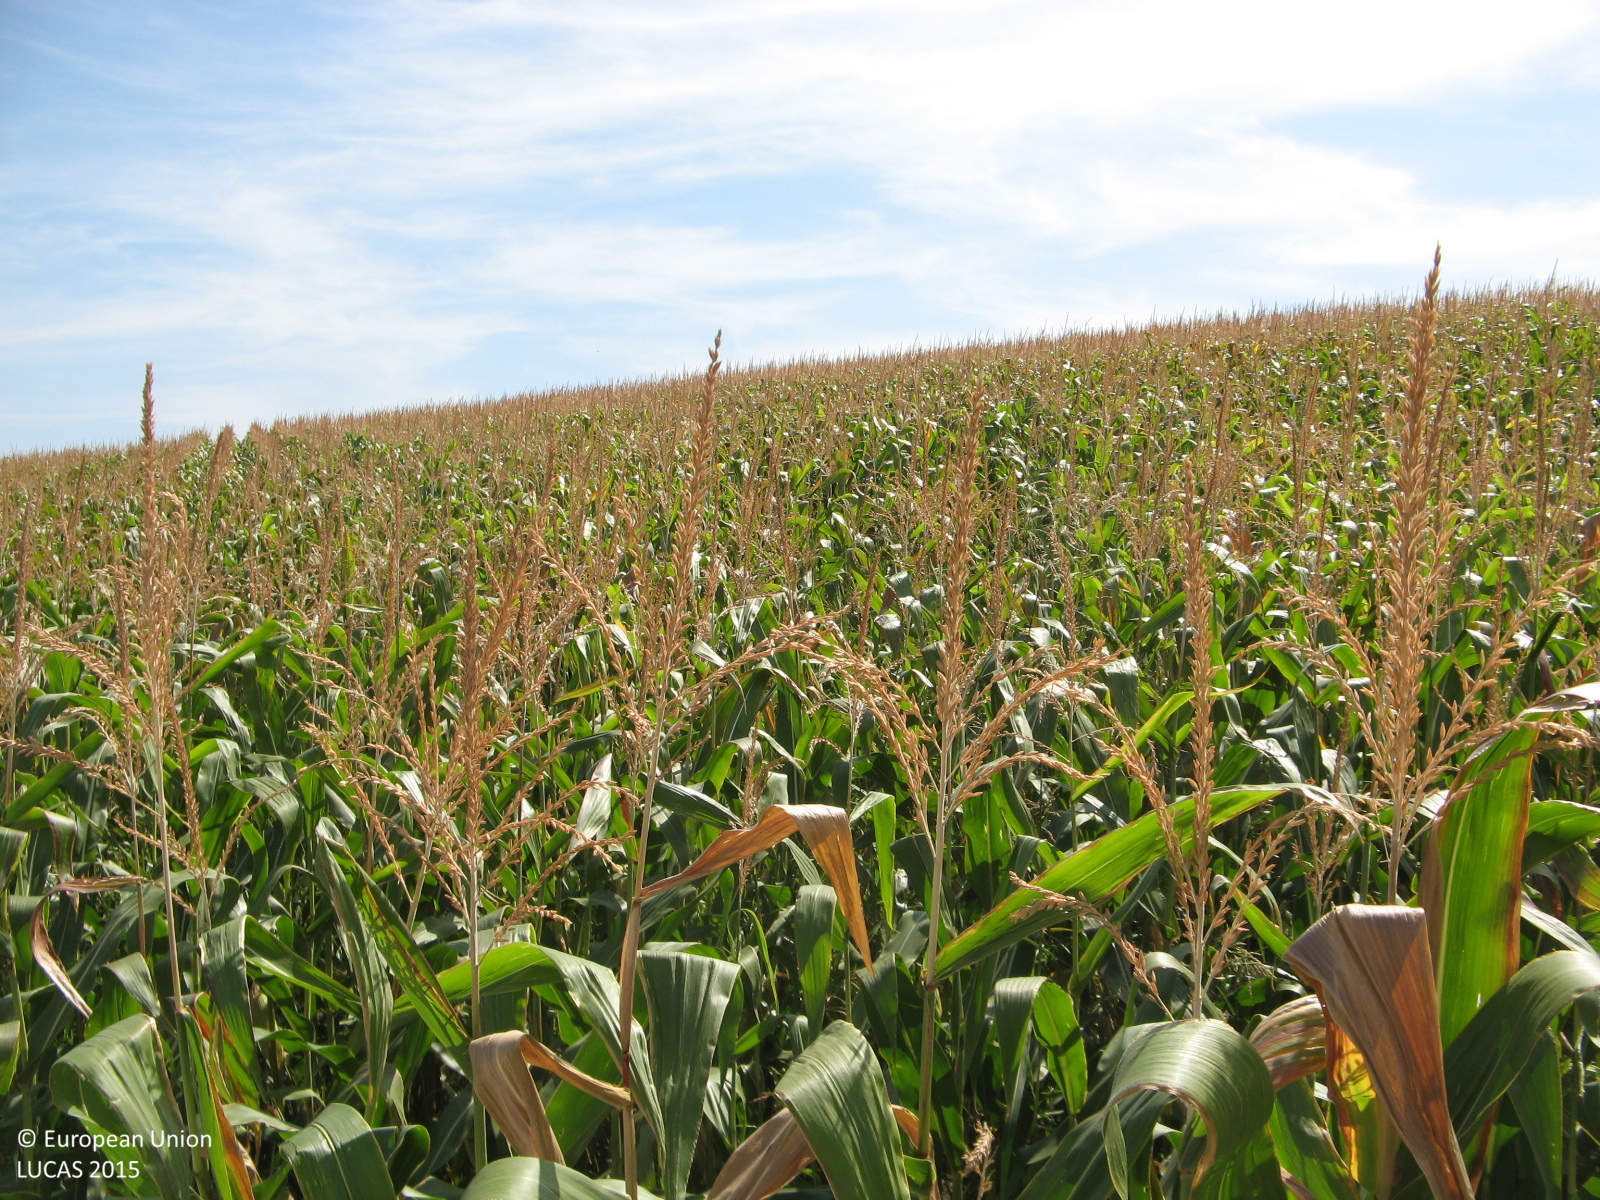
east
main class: Cropland
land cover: Maize
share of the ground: > 75 %
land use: Agriculture (excluding fallow land and kitchen gardens)
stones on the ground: < 10 %
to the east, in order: Maize
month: August
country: BG
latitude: 43.6590
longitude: 25.8262
